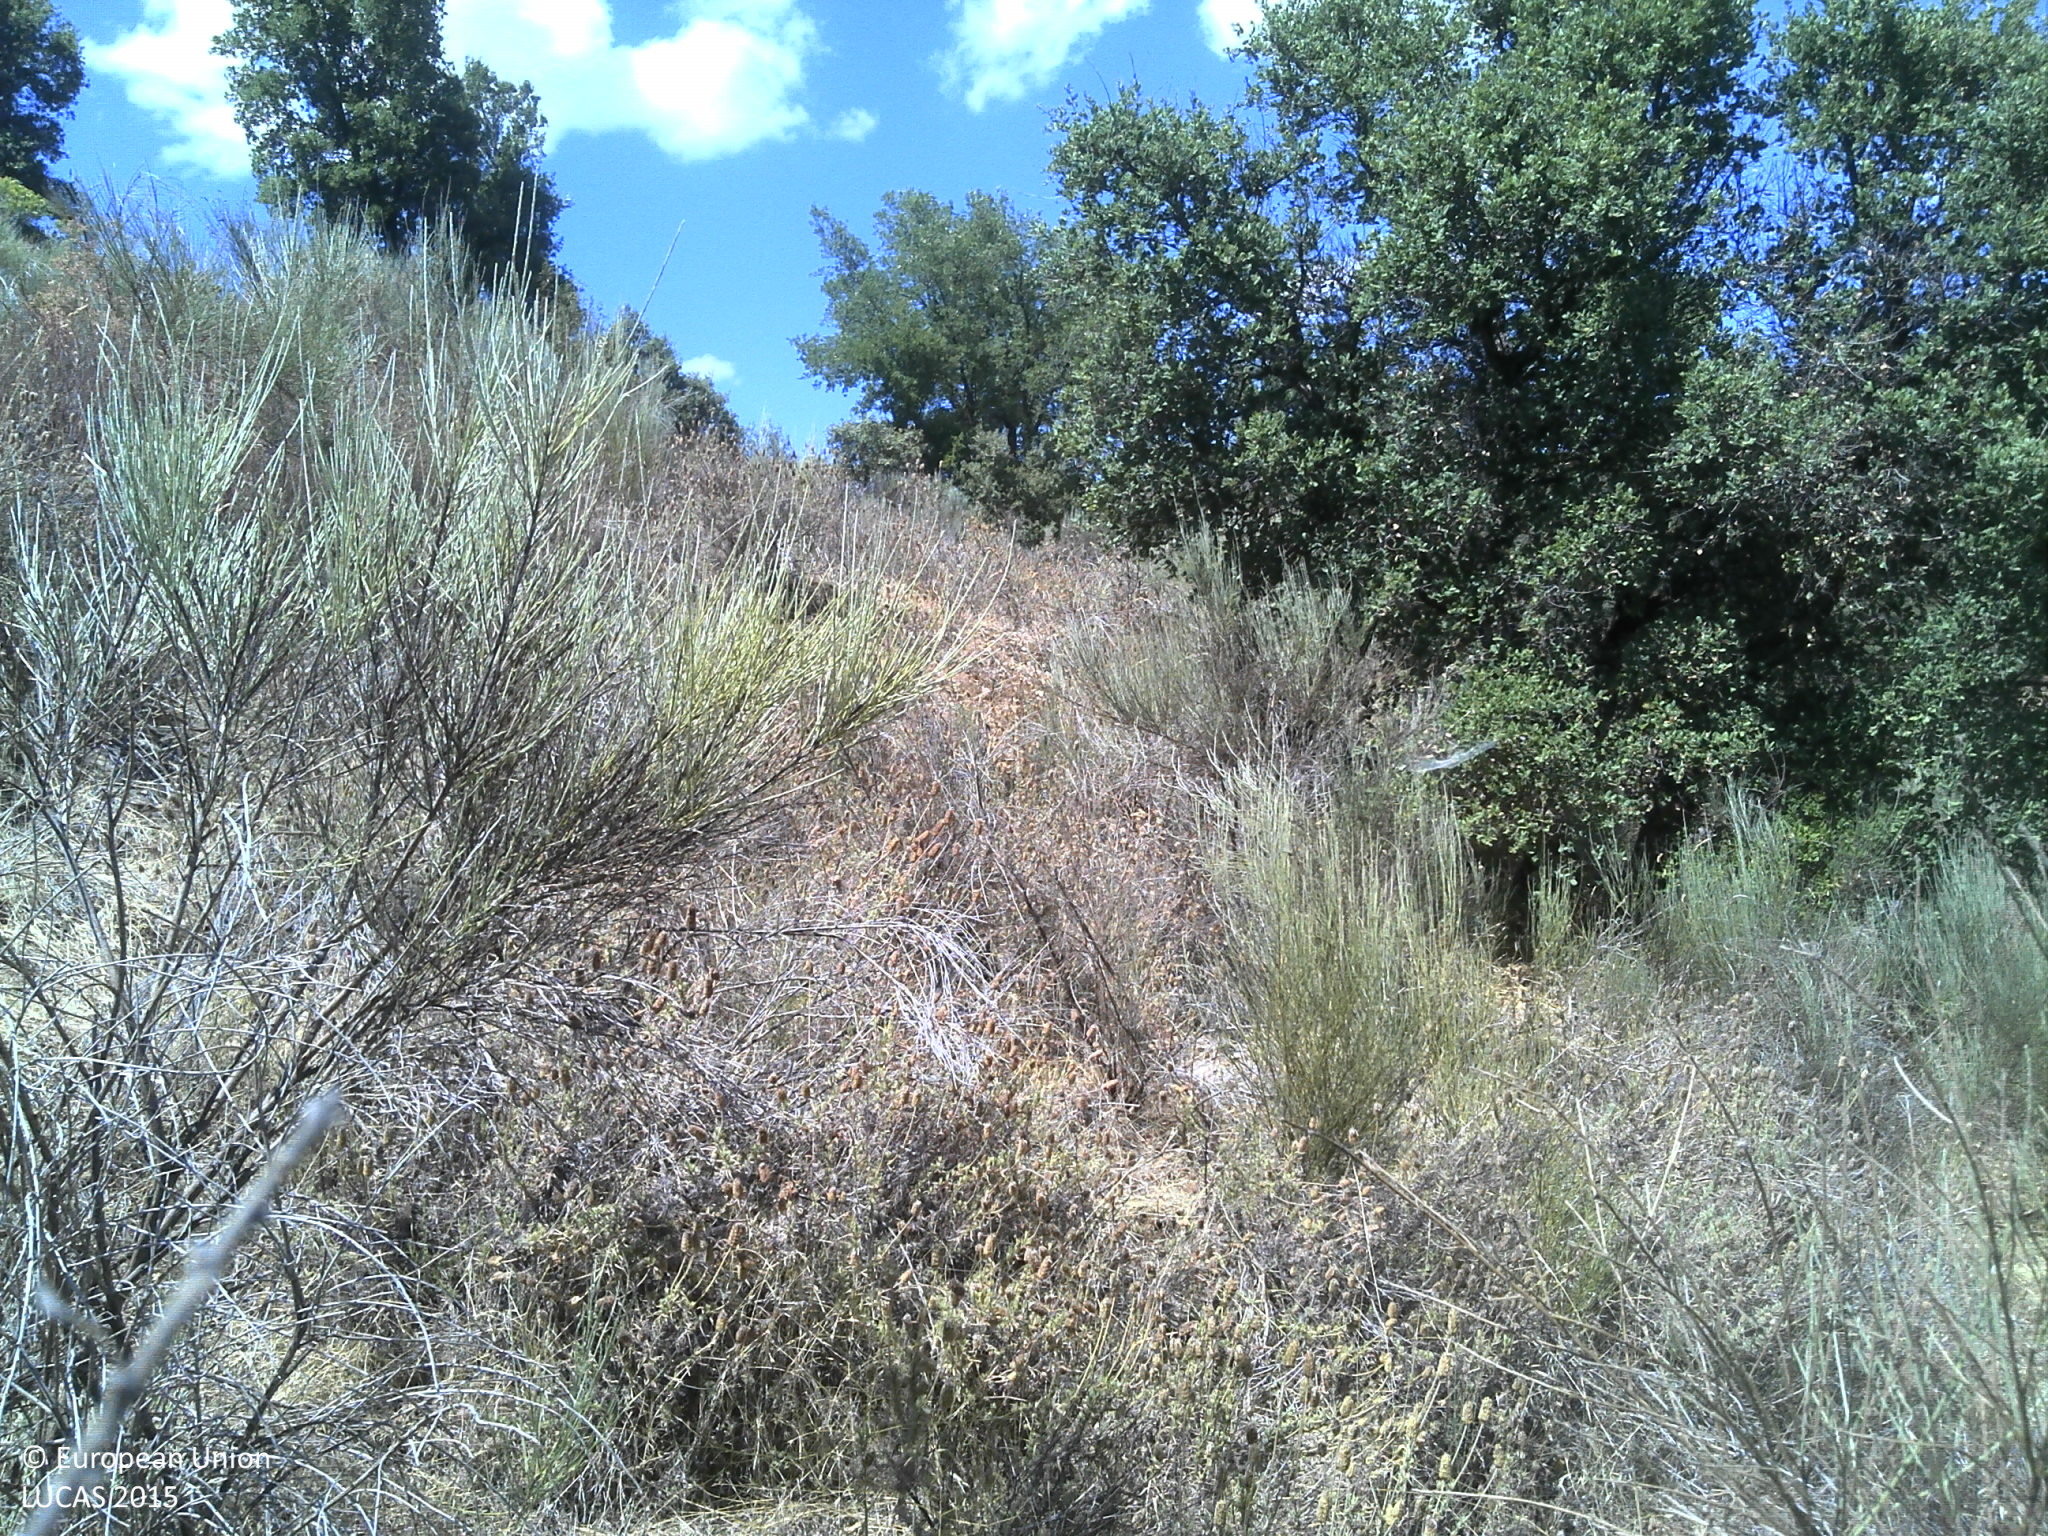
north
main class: Shrubland
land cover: Shrubland with sparse tree cover
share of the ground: > 75 %
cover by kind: shrubs 95 %, broadleaved forest trees 5 %
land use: Semi-natural and natural areas not in use
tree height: < 5 m
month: July
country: PT
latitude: 41.3517
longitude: -7.0008
